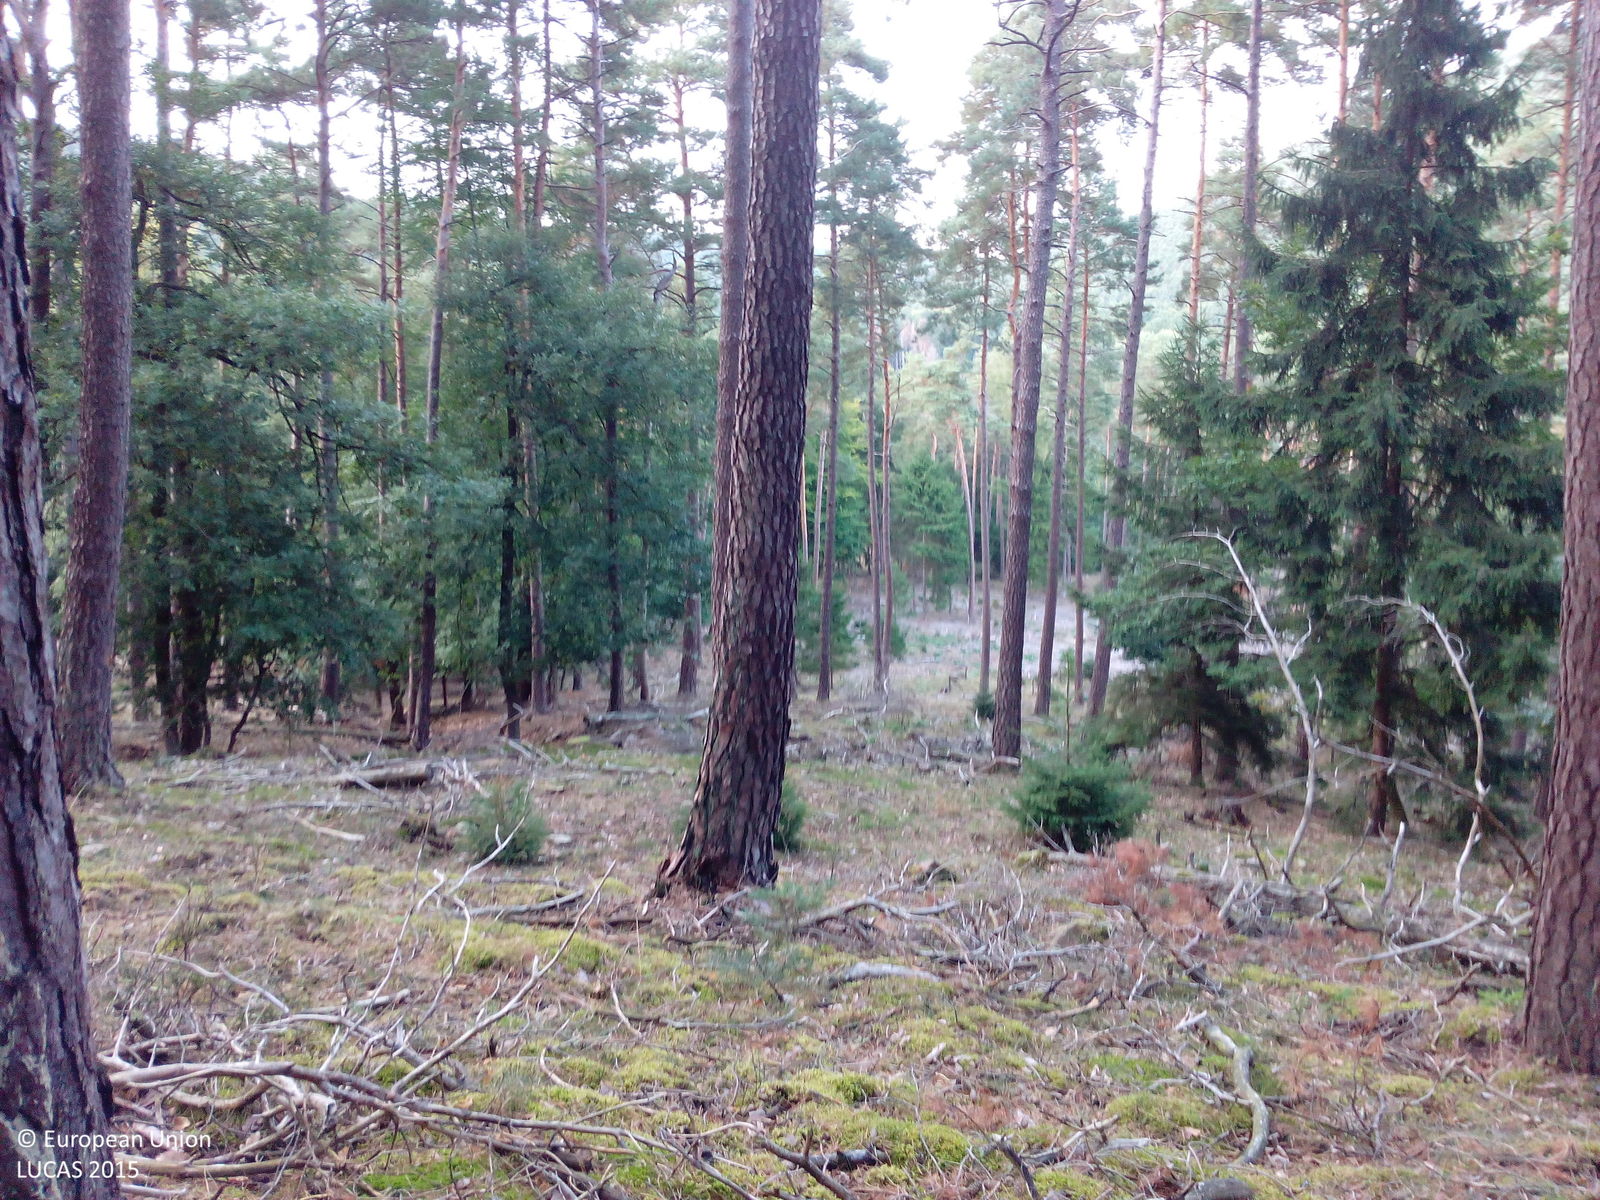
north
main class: Woodland
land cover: Pine dominated coniferous woodland
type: hemiboreal forest and nemoral coniferous forest and mixed broadleaved-coniferous forest
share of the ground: > 75 %
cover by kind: coniferous forest trees 85 %, broadleaved forest trees 5 %, herbaceous plants 5 %, lichens and mosses 5 %
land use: Forestry
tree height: > 5 m
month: September
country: DE
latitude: 49.3043
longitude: 8.0614
